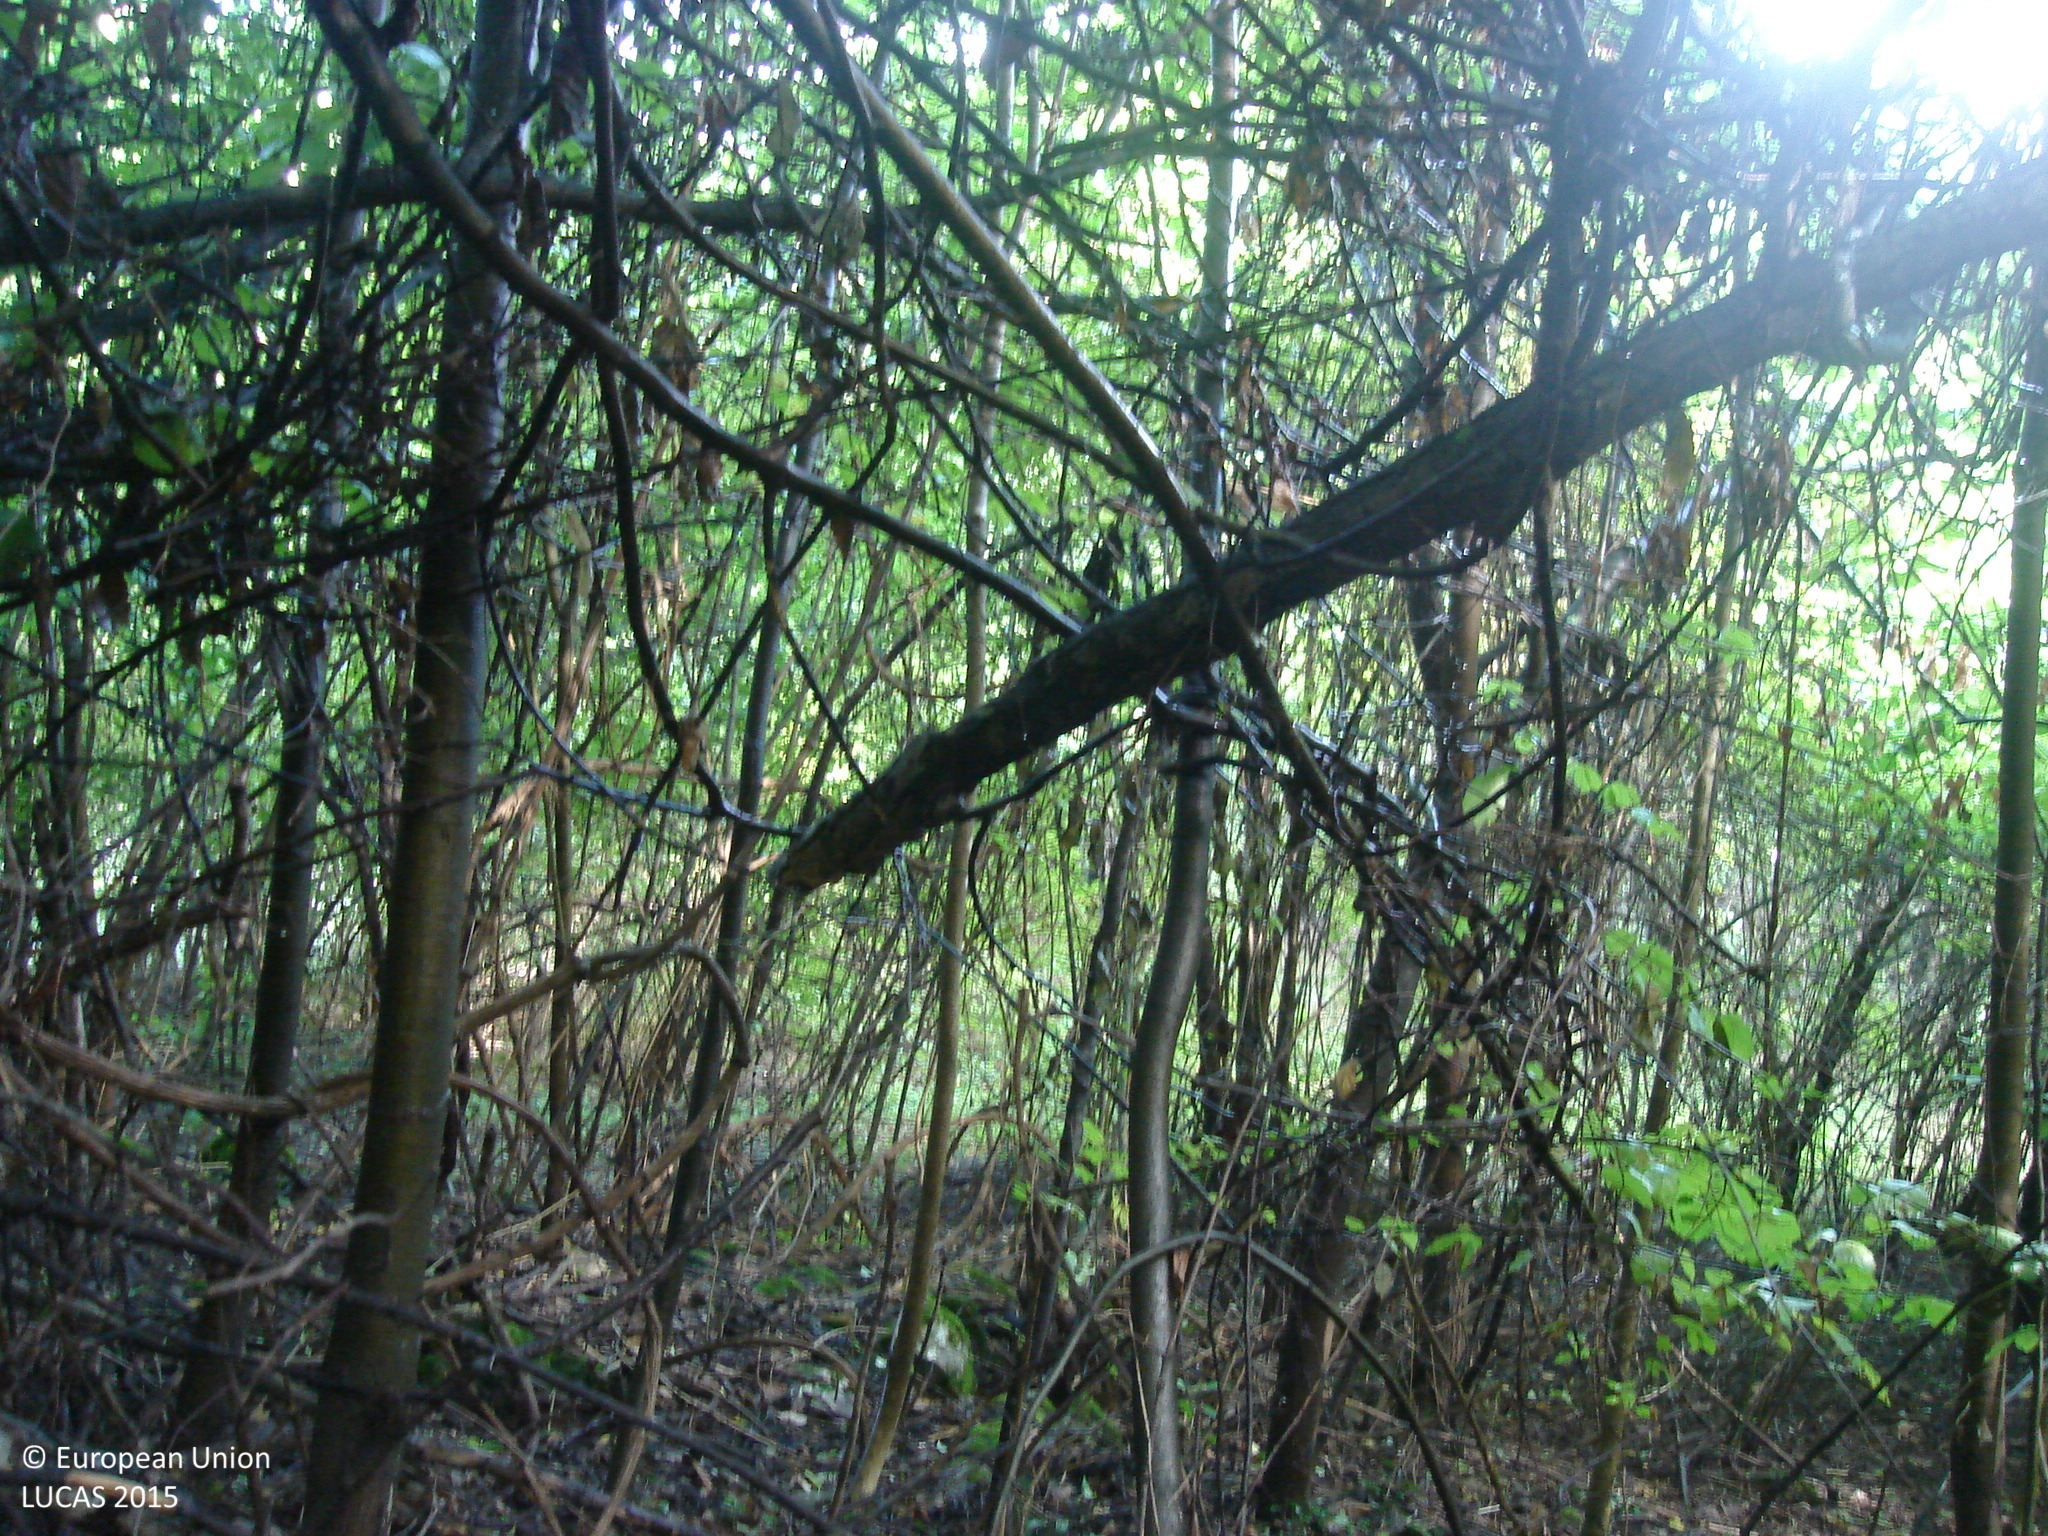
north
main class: Woodland
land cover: Broadleaved woodland
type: mesophytic deciduous forest
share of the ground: > 75 %
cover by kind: broadleaved forest trees 80 %, unconsolidated bare surface 10 %, shrubs 5 %, lichens and mosses 5 %
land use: Forestry
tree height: > 5 m
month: October
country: BG
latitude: 43.0910
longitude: 23.4178
